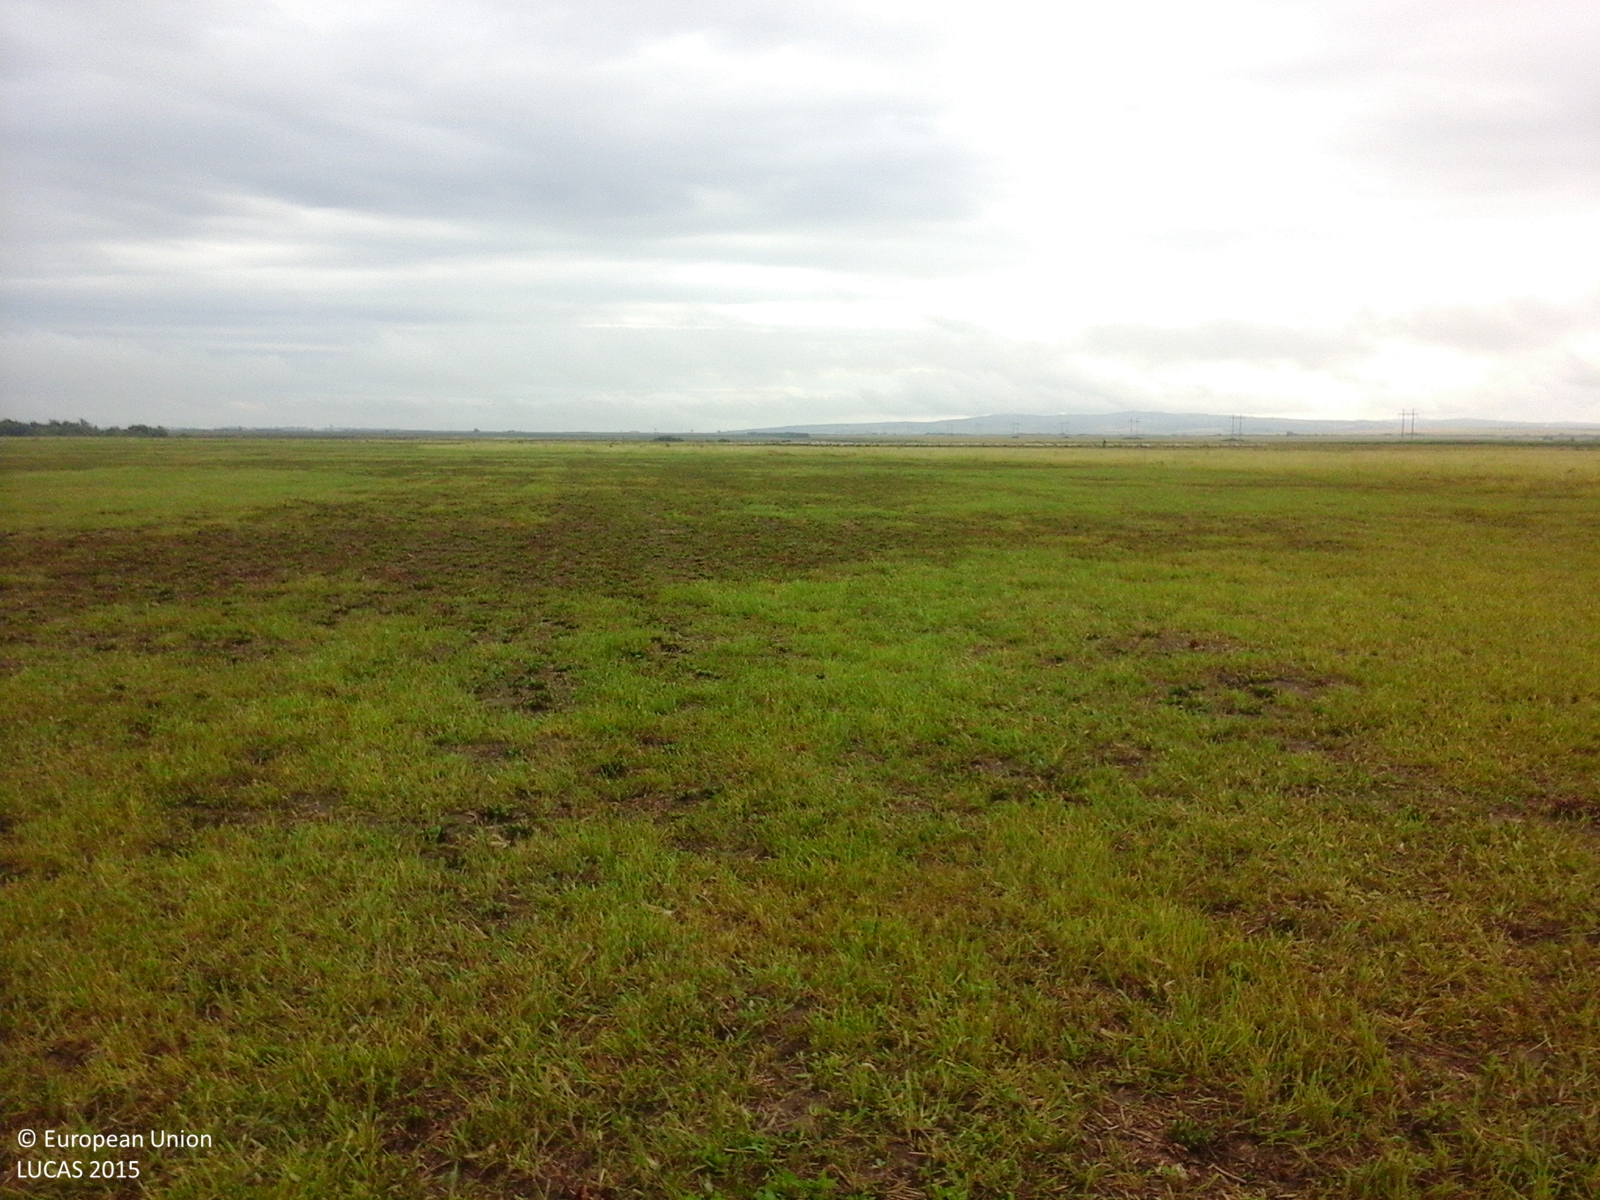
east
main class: Grassland
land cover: Grassland without tree/shrub cover
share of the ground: > 75 %
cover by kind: herbaceous plants 100 %
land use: Agriculture (excluding fallow land and kitchen gardens)
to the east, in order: Grassland without tree/shrub cover; Ditches and canals; Grassland without tree/shrub cover
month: August
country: RO
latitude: 45.6362
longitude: 21.5148
